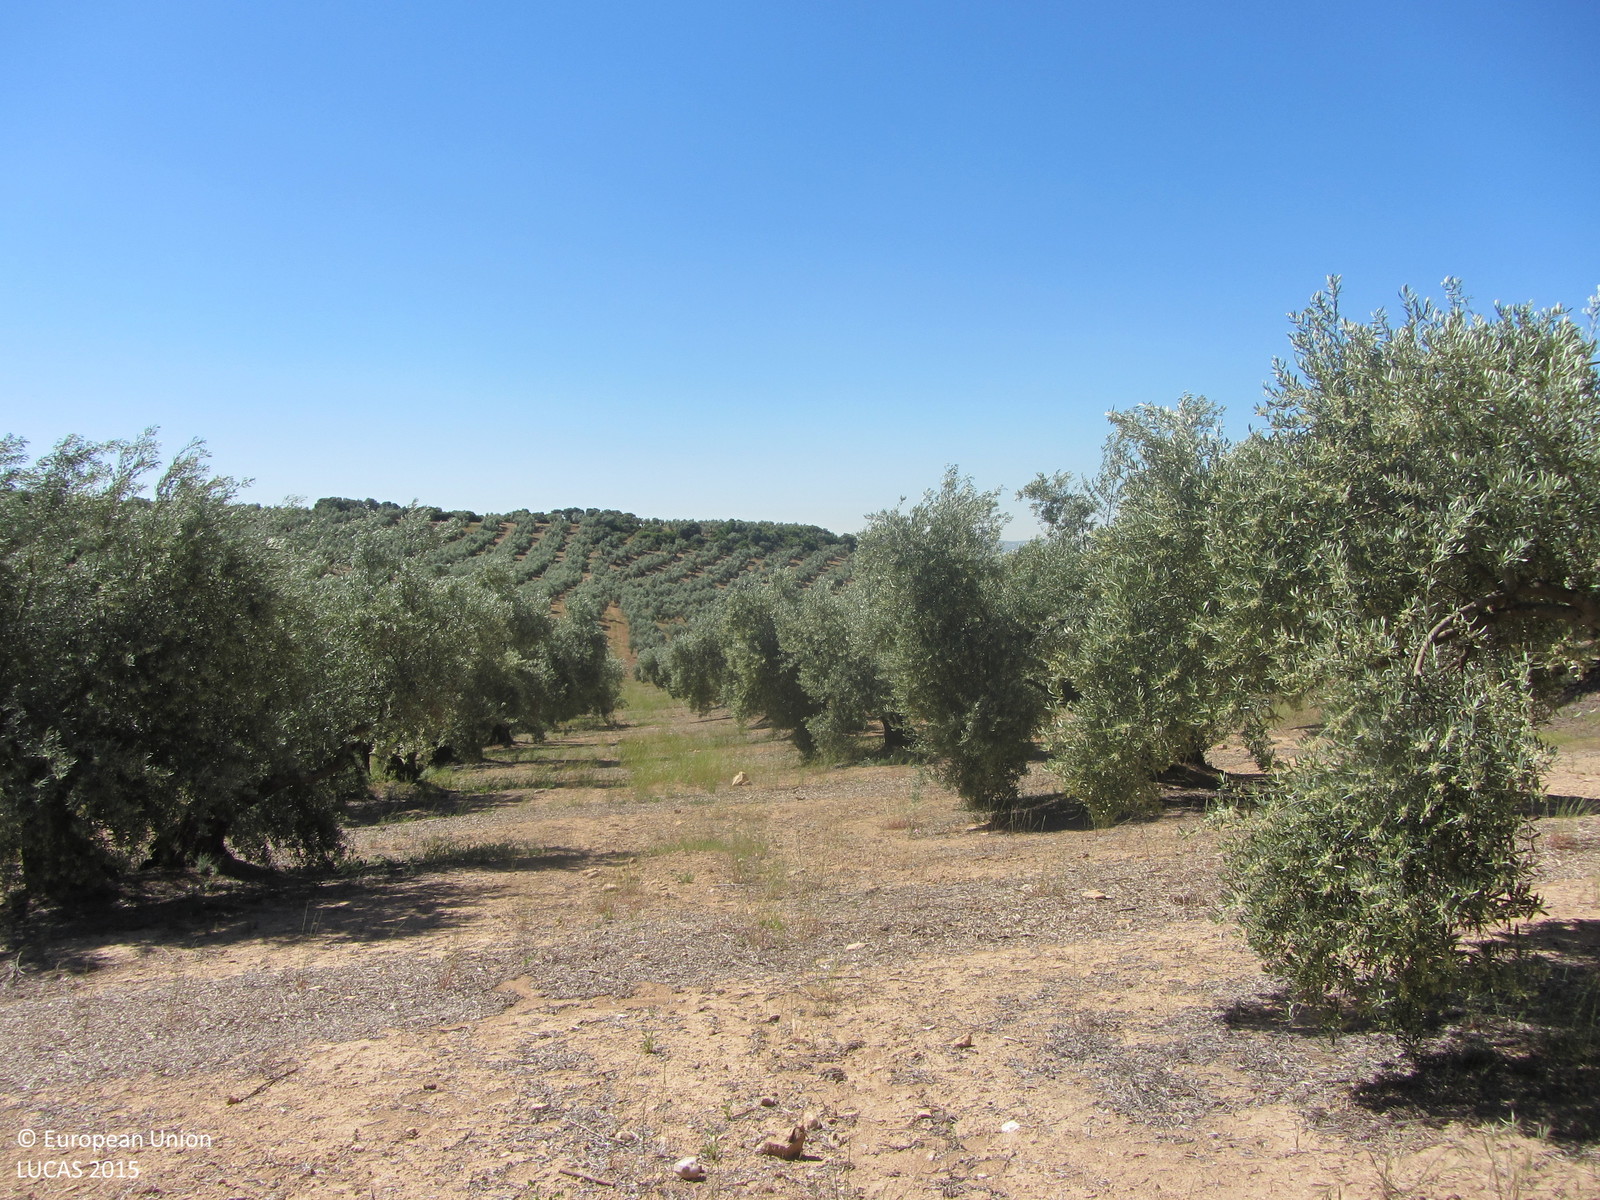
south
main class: Cropland
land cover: Olive groves
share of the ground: 25 - 50 %
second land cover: Other bare soil
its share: > 75 %
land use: Agriculture (excluding fallow land and kitchen gardens)
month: May
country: ES
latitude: 38.2513
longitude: -3.0848
